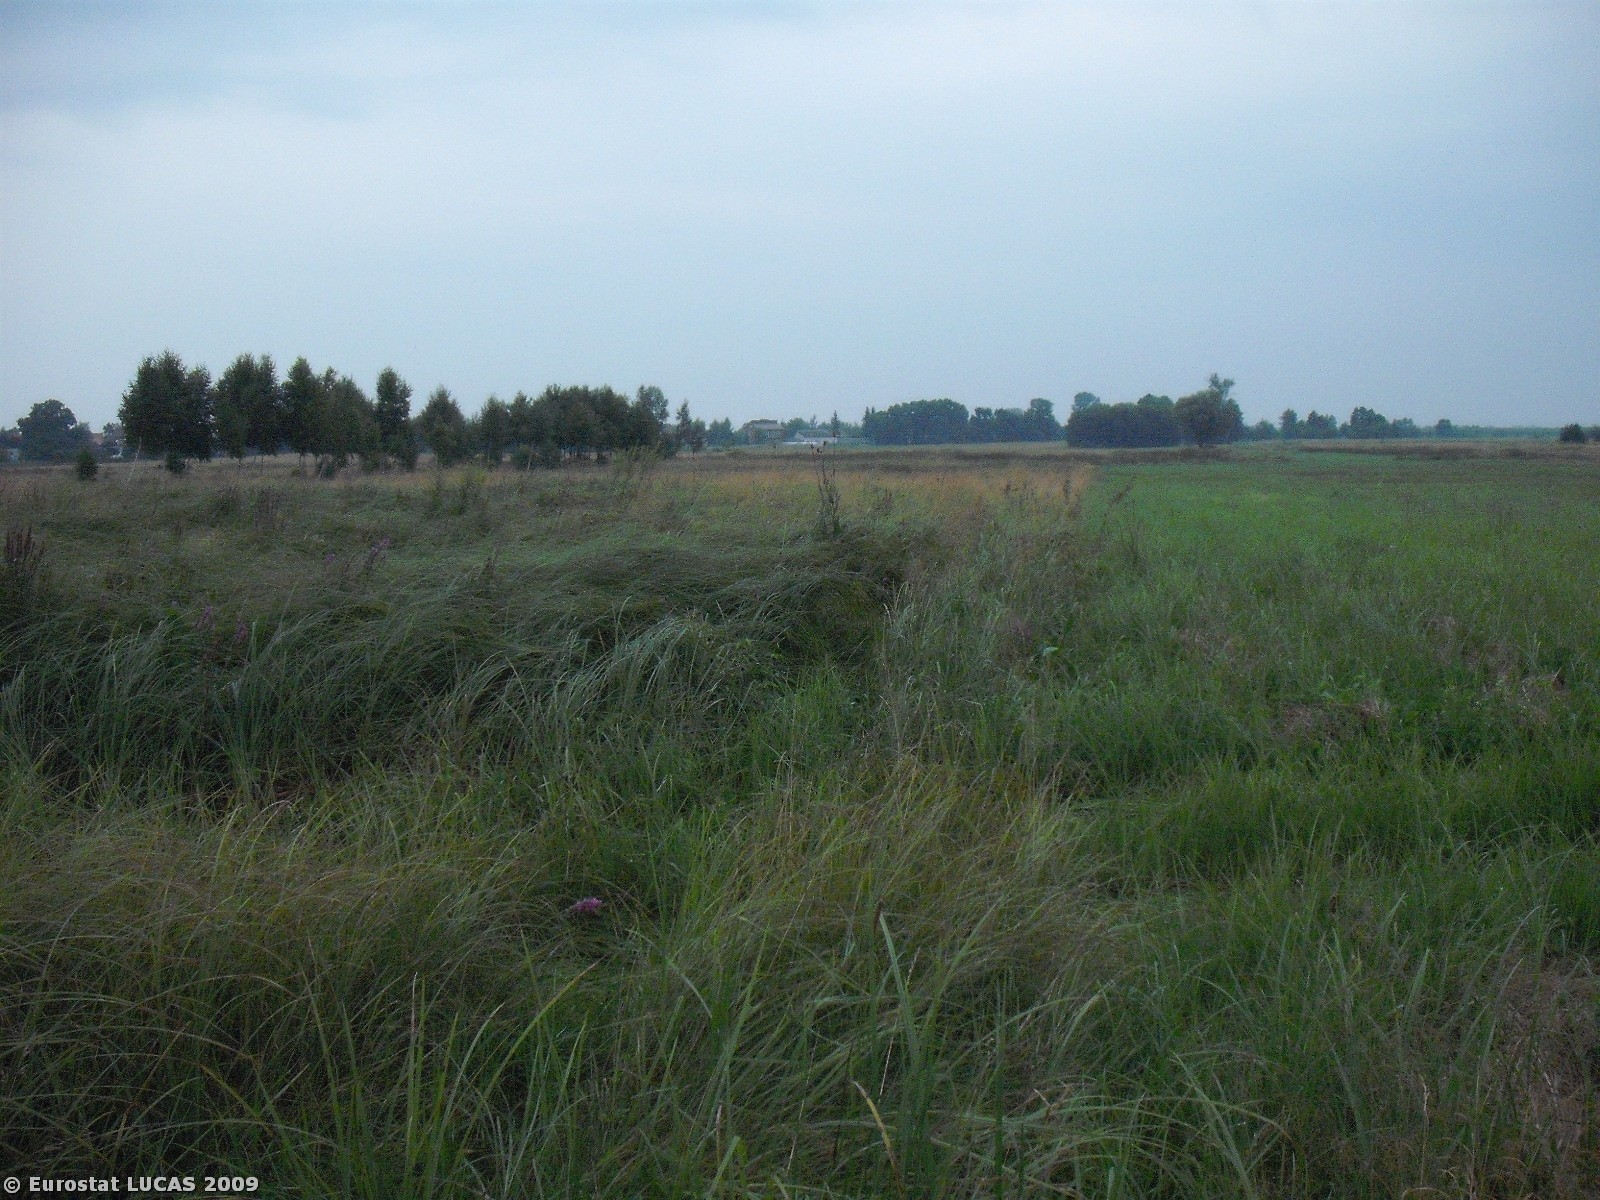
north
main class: Grassland
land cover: Grassland without tree/shrub cover
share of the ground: > 75 %
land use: Agriculture (excluding fallow land and kitchen gardens)
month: August
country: PL
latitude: 50.0799
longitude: 22.4599
